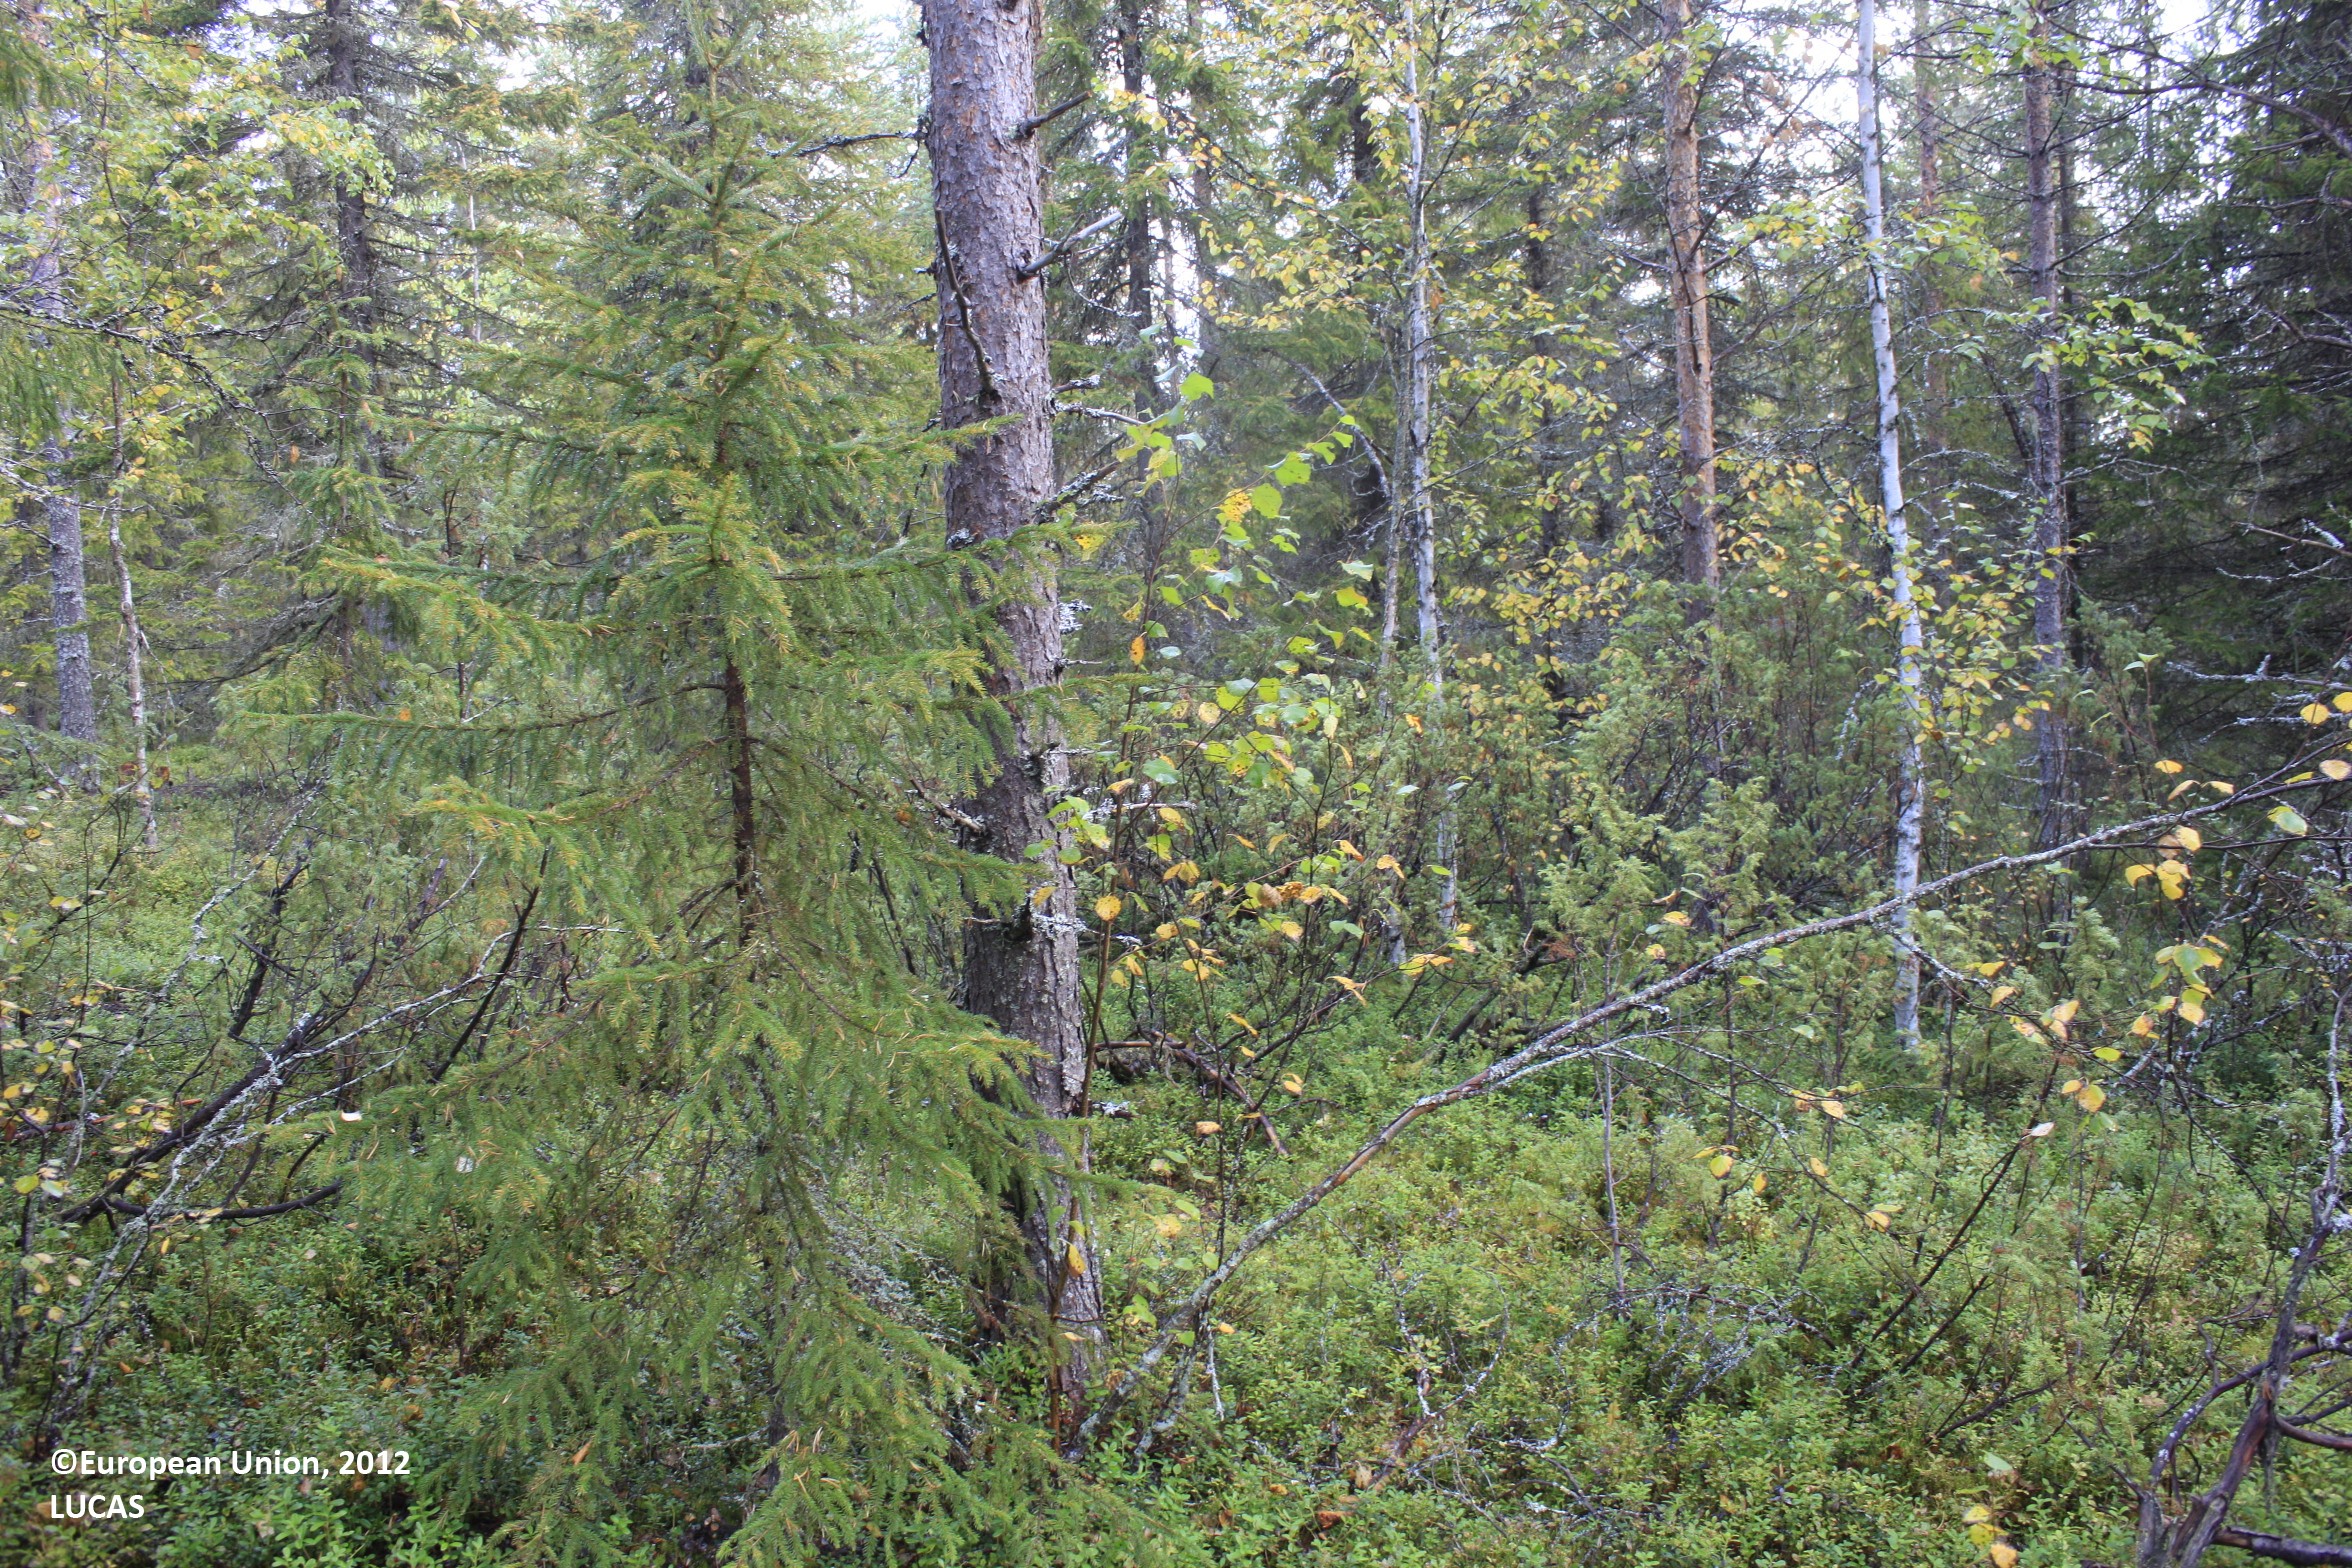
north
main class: Woodland
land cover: Pine dominated mixed woodland
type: boreal forest
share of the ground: 25 - 50 %
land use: Forestry
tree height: > 5 m
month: September
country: FI
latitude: 65.6367
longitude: 26.7249
